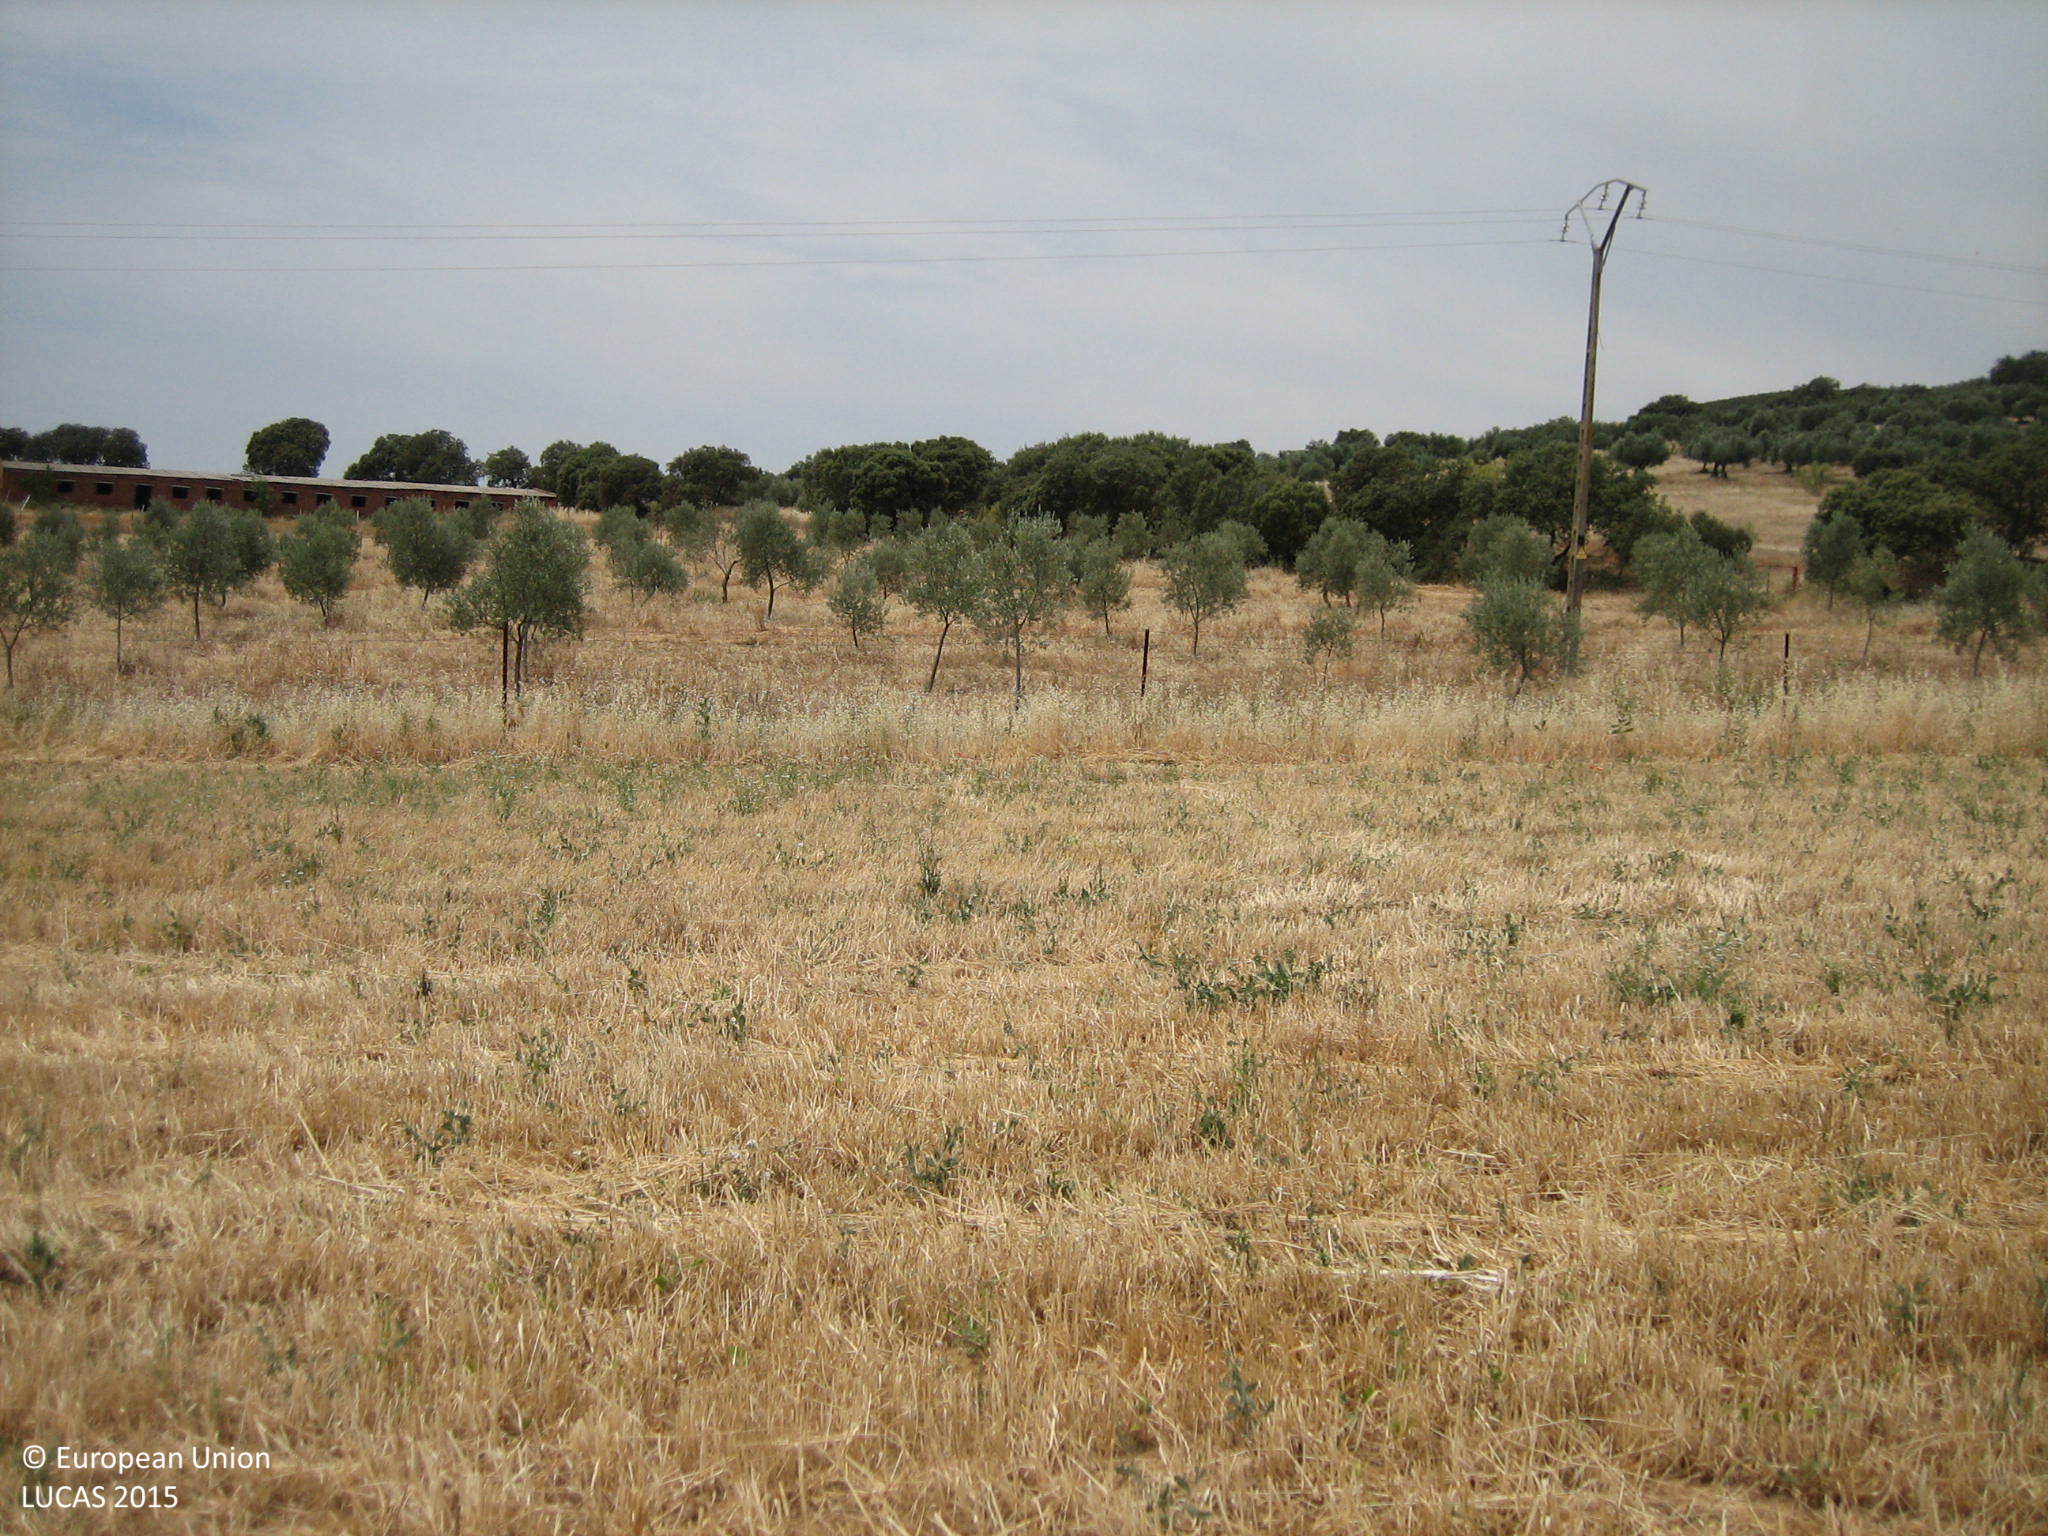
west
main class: Cropland
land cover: Oats
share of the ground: 25 - 50 %
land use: Agriculture (excluding fallow land and kitchen gardens)
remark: Harvested field
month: June
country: ES
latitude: 39.2173
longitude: -4.5212
